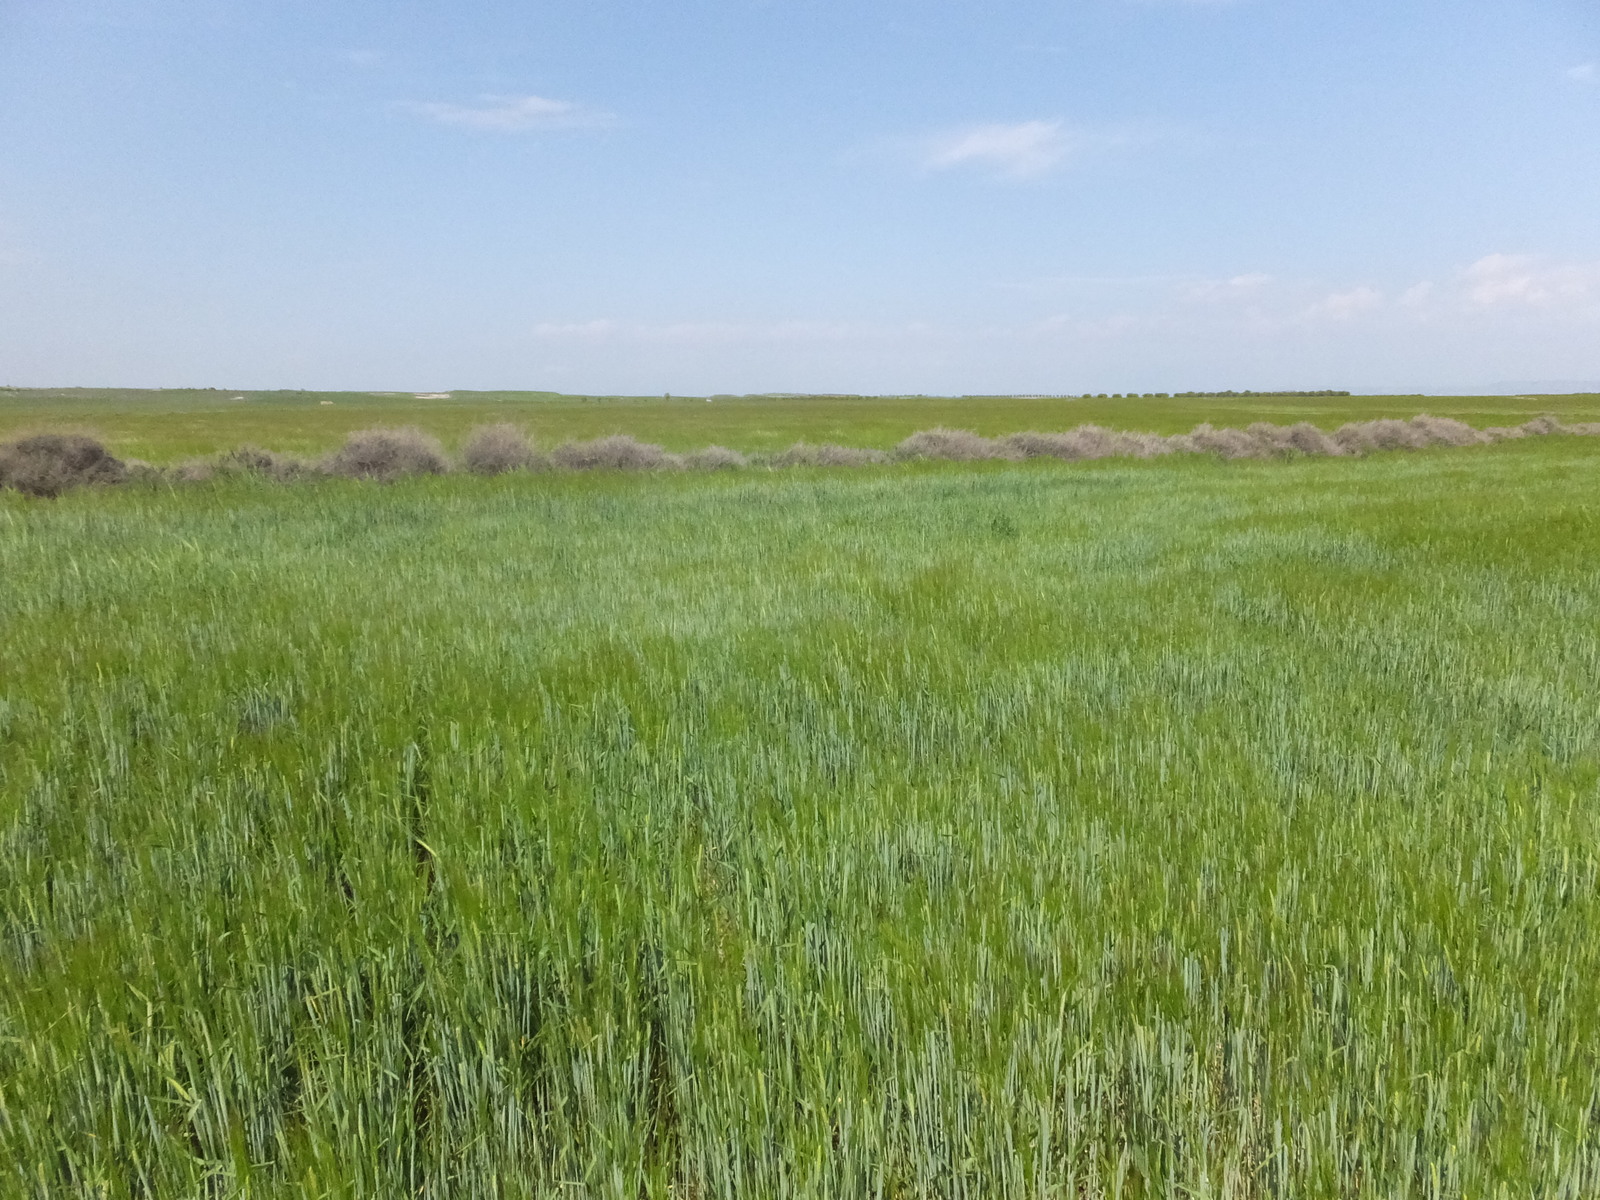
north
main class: Cropland
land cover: Barley
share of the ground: > 75 %
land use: Agriculture (excluding fallow land and kitchen gardens)
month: April
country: ES
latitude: 41.7713
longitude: -0.4011
